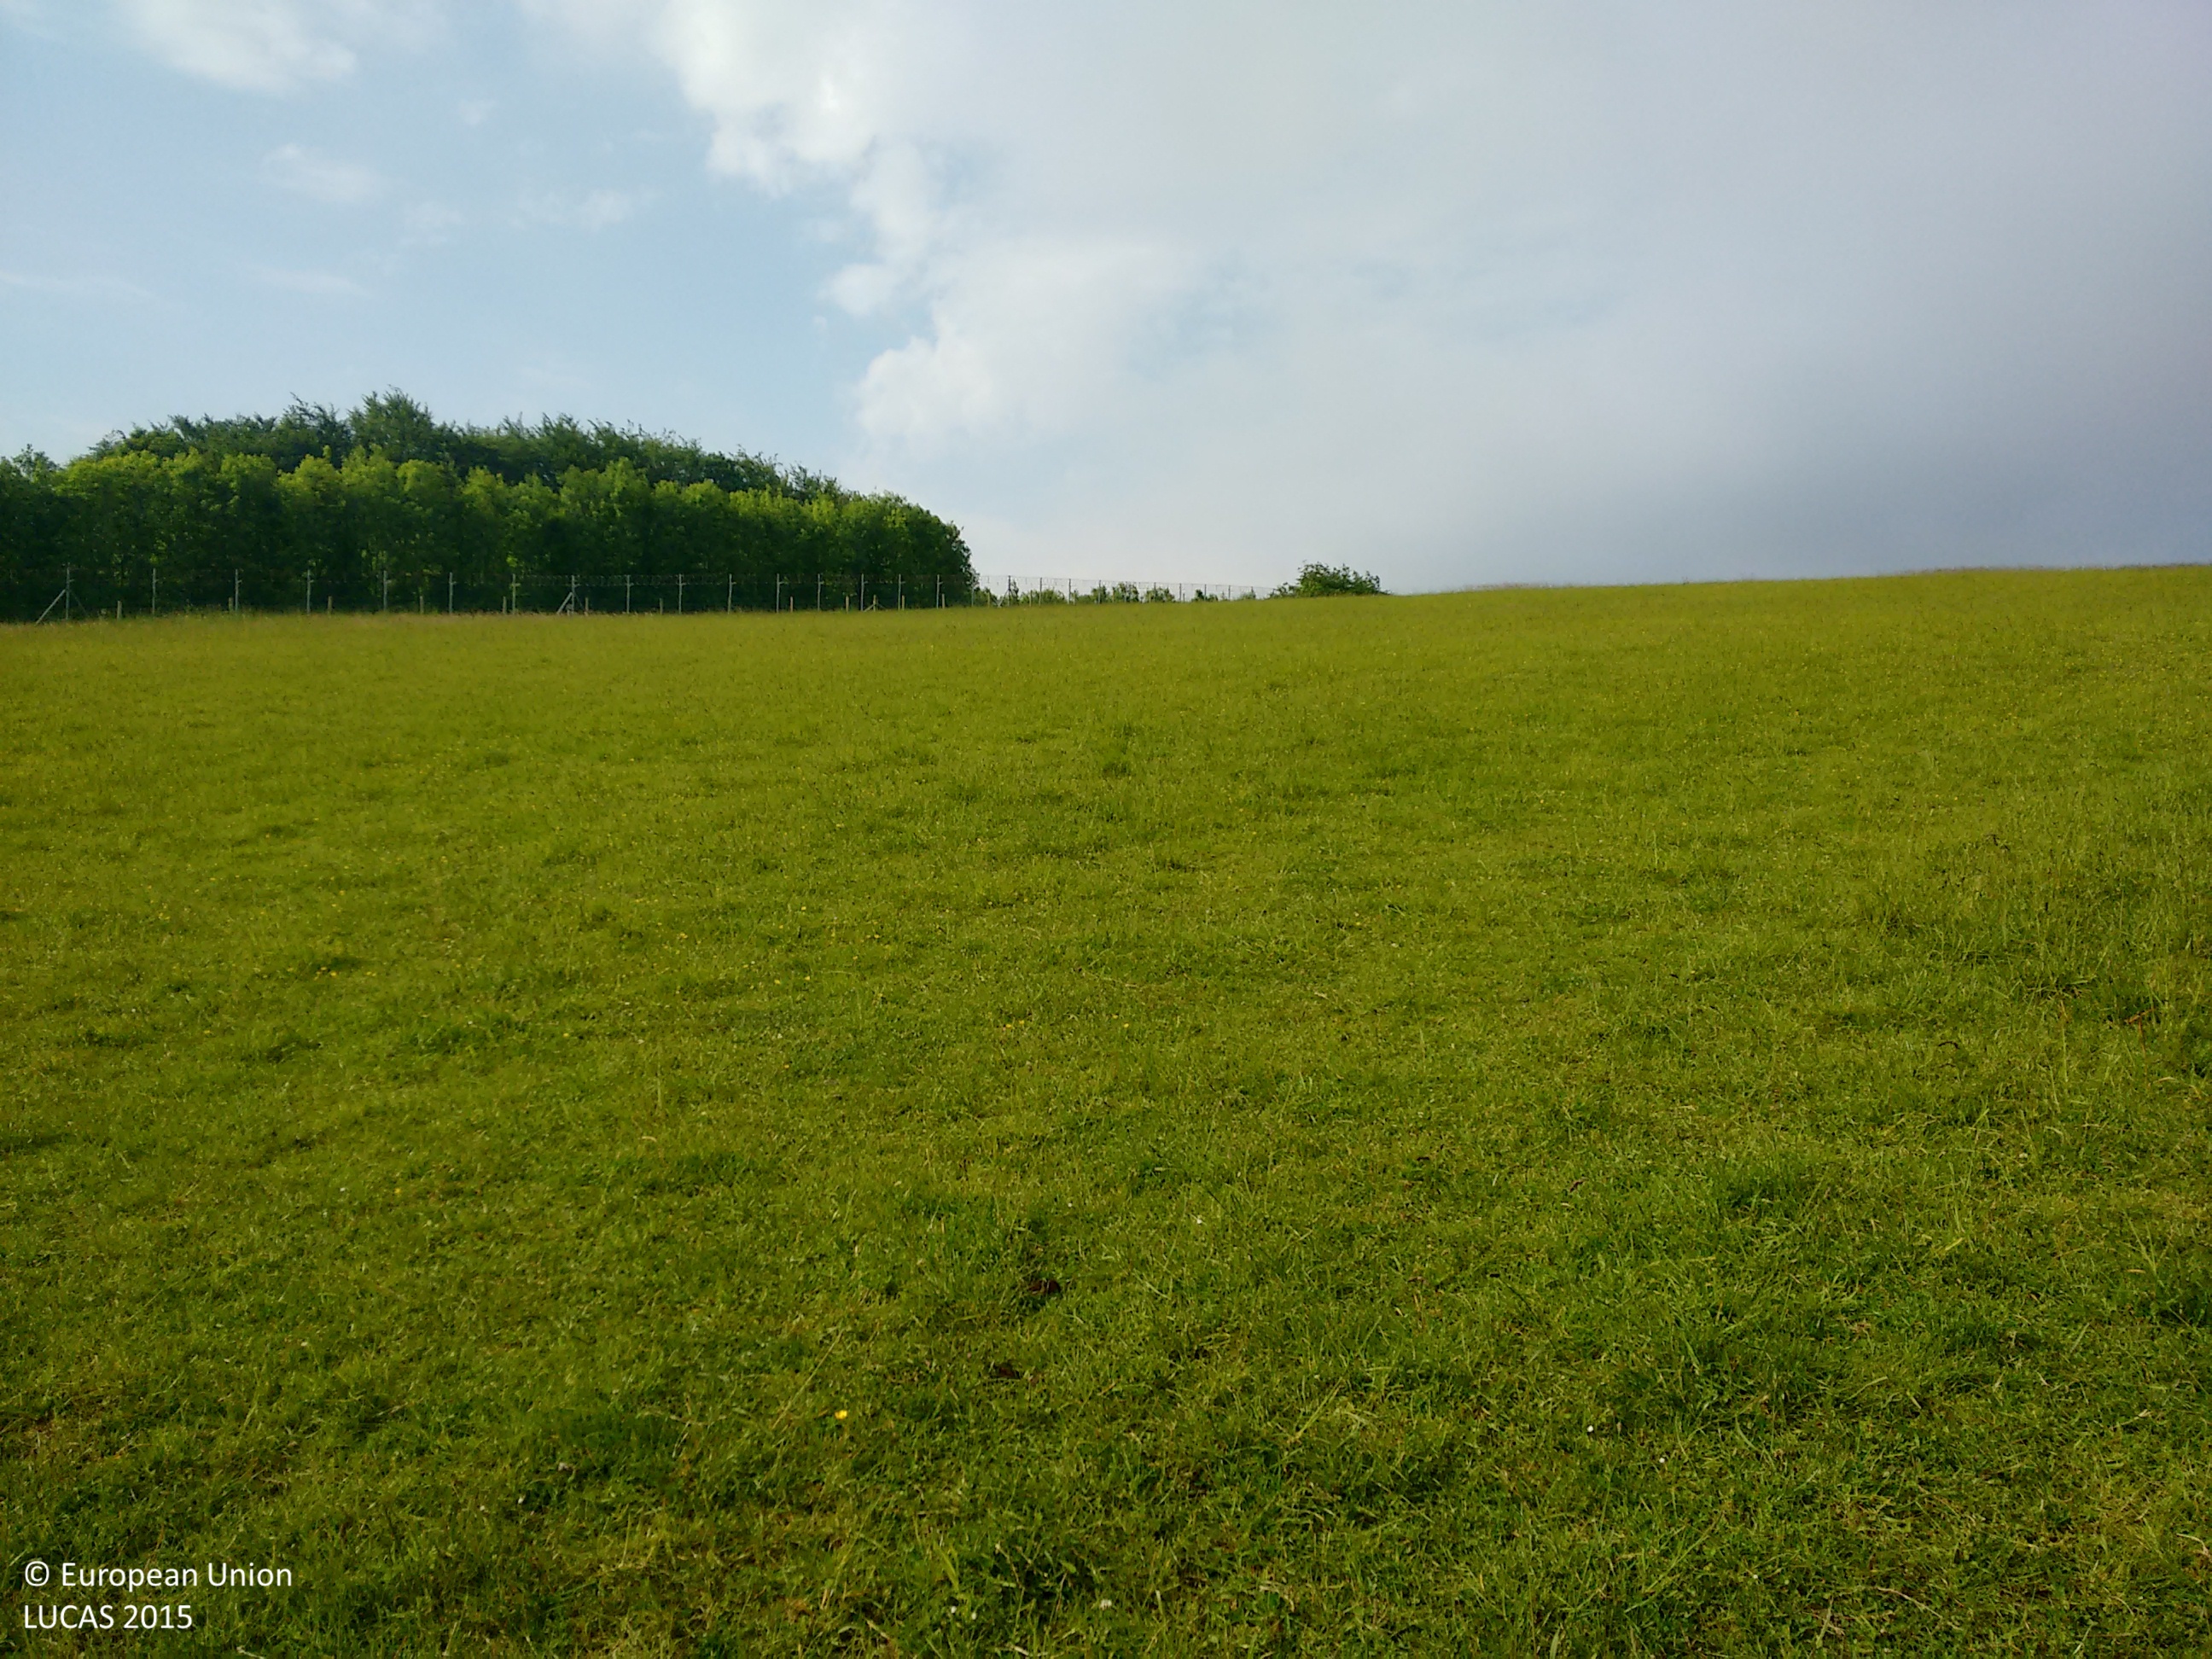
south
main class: Cropland
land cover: Barley
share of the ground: > 75 %
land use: Agriculture (excluding fallow land and kitchen gardens)
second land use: Community services
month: June
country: GB
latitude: 51.2220
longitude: -2.1599
